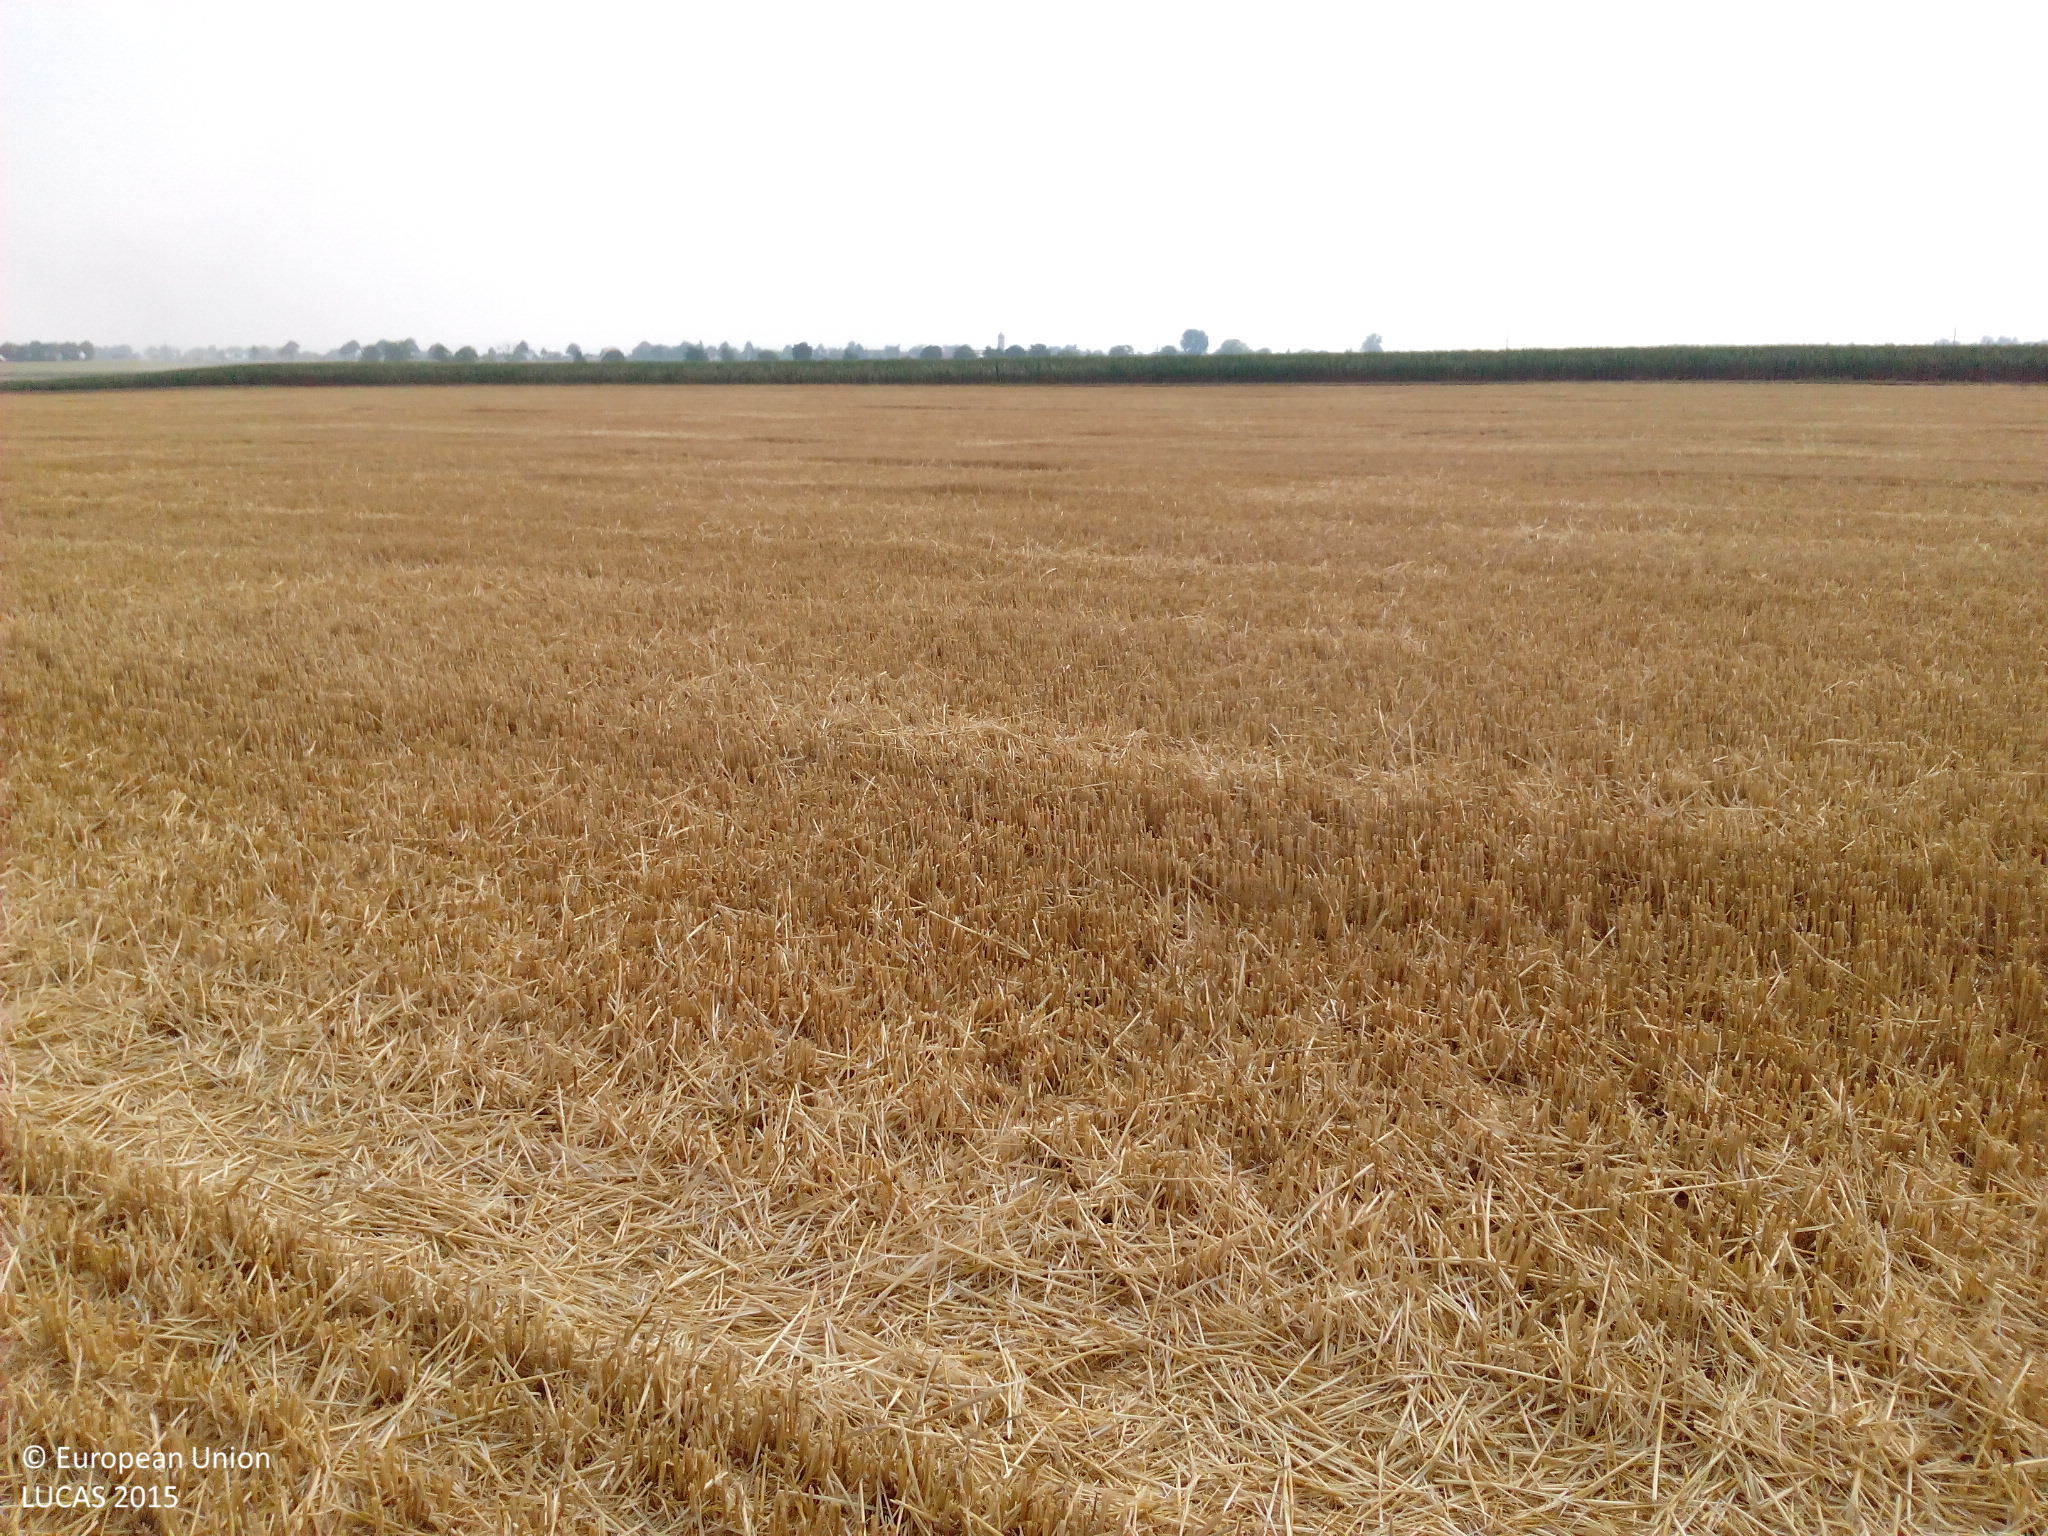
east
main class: Cropland
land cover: Common wheat
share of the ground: 50 - 75 %
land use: Agriculture (excluding fallow land and kitchen gardens)
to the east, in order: Common wheat; Grass margins; Paved roads, cycling and walking lanes; Grass margins; Other bare soil; Maize
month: August
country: DE
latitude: 48.9060
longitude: 10.5318
